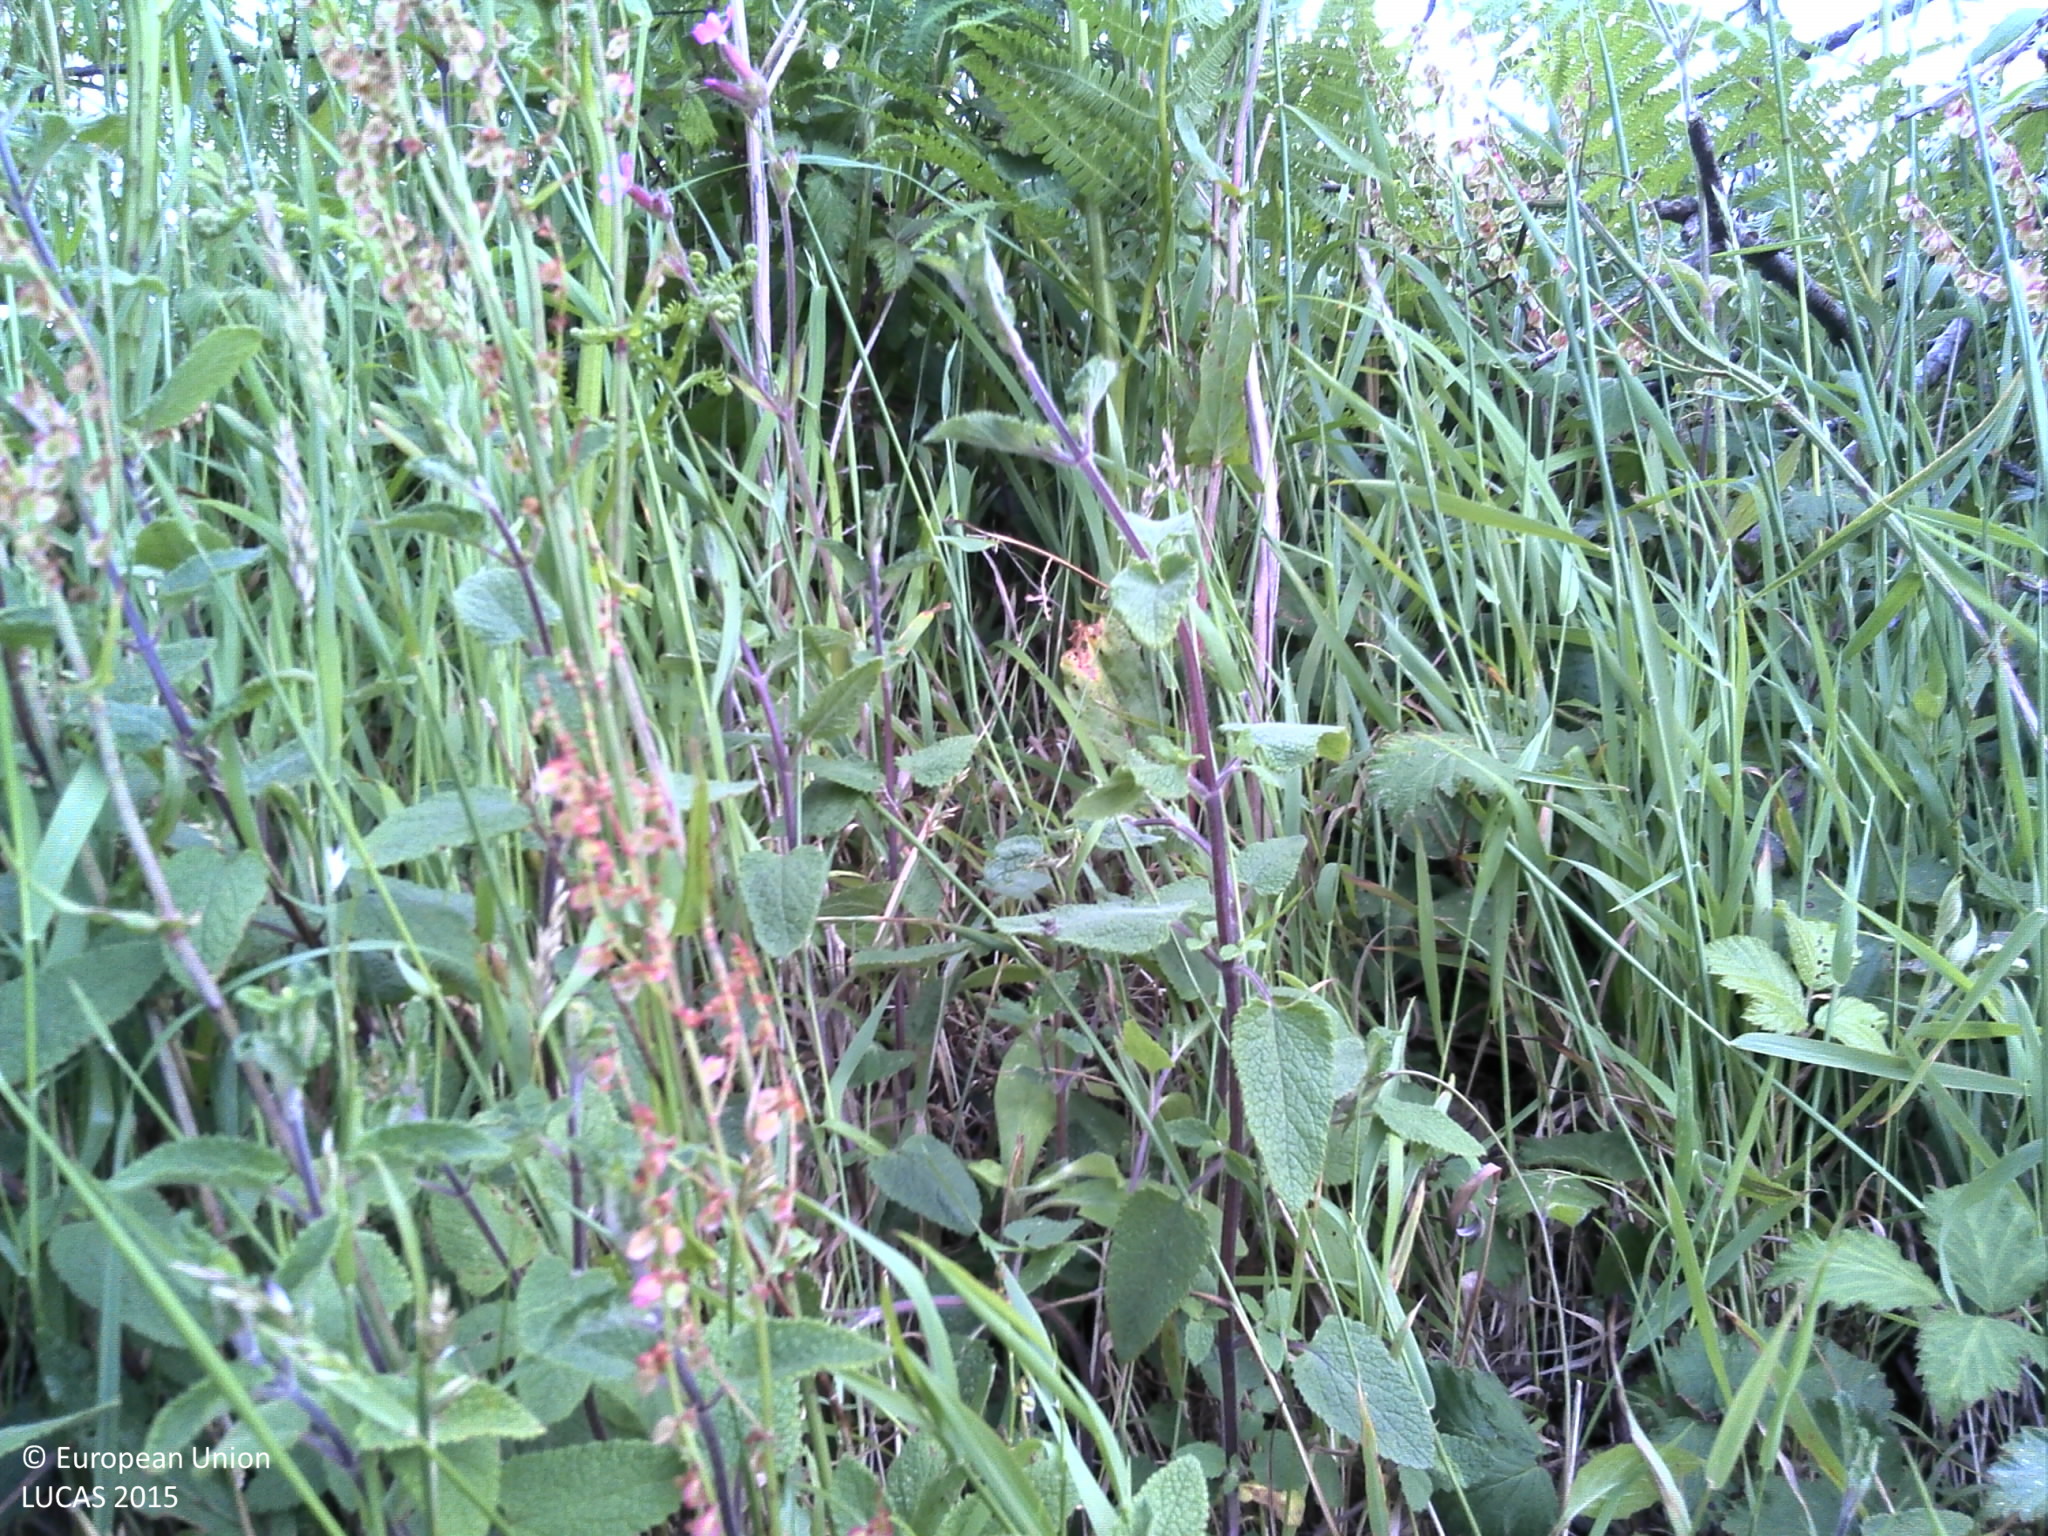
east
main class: Cropland
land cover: Maize
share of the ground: 10 - 25 %
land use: Agriculture (excluding fallow land and kitchen gardens)
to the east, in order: Managed hedges; Electric lines; Maize; Grass margins; Tracks; Grass margins; Managed hedges; Maize; Managed hedges; Maize
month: June
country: FR
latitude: 47.9818
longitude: -3.5695
